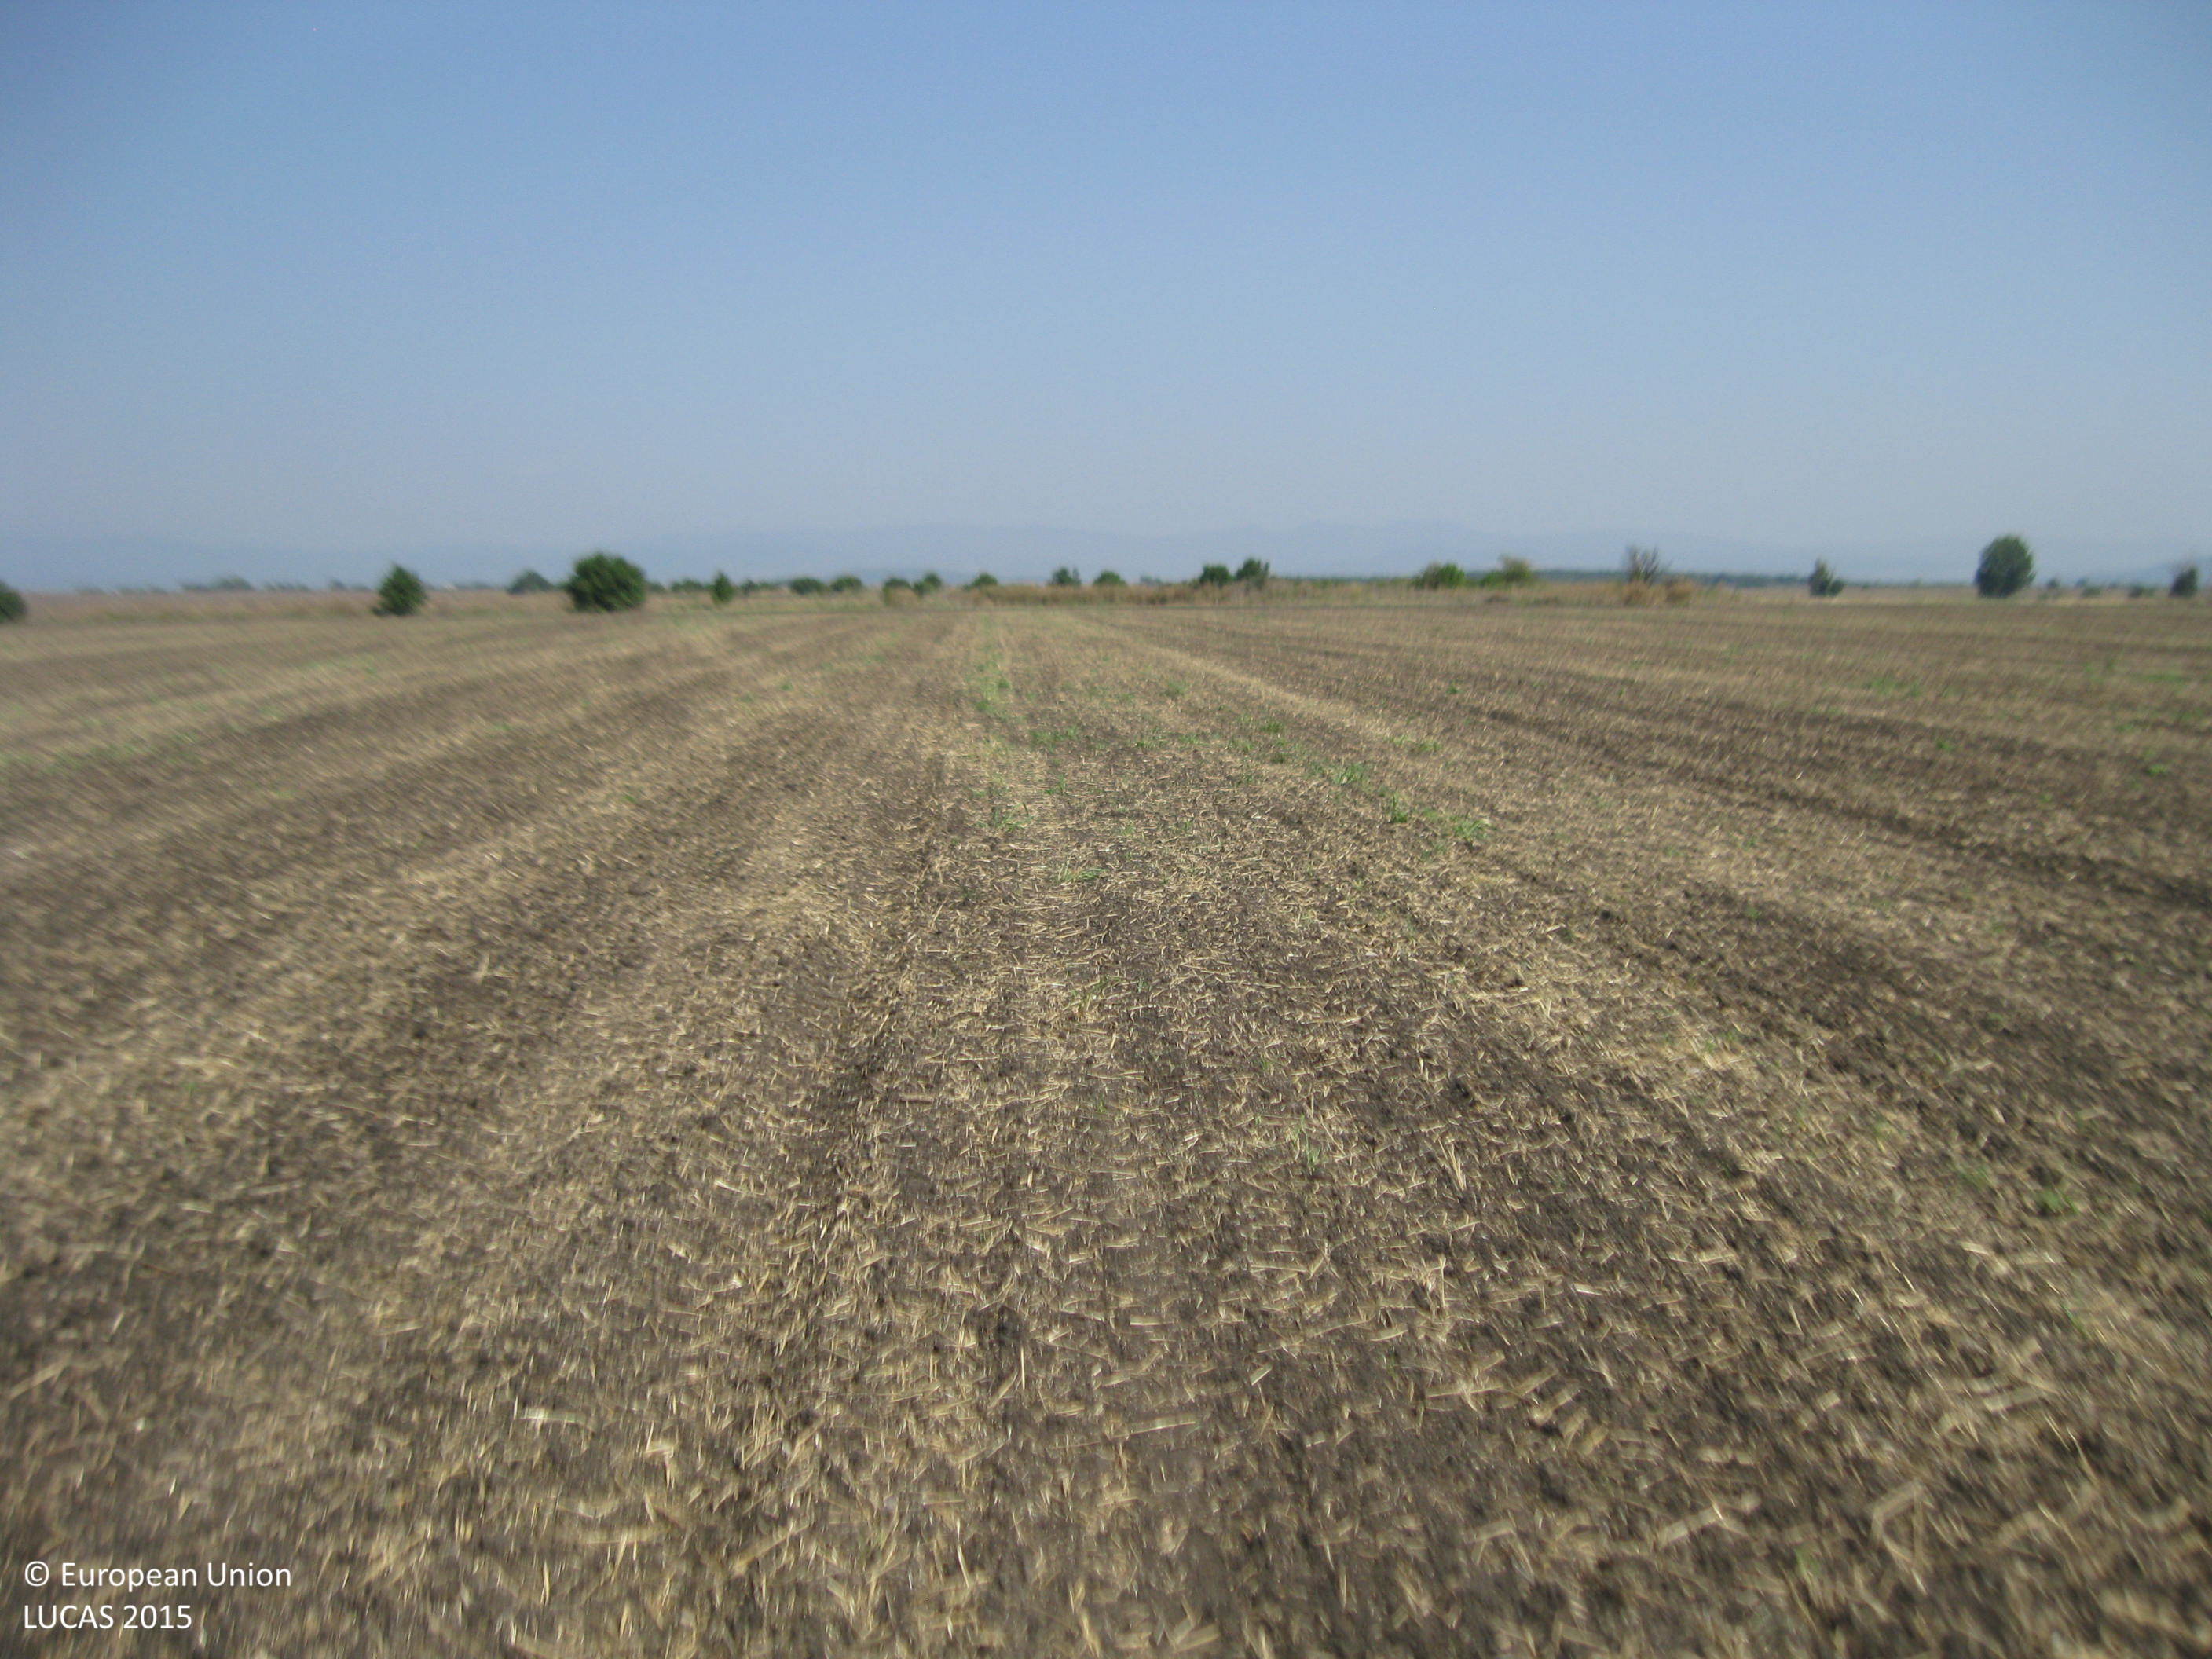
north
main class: Cropland
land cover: Common wheat
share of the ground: < 10 %
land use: Agriculture (excluding fallow land and kitchen gardens)
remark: Harvested field
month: September
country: BG
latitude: 42.2765
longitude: 25.0331
